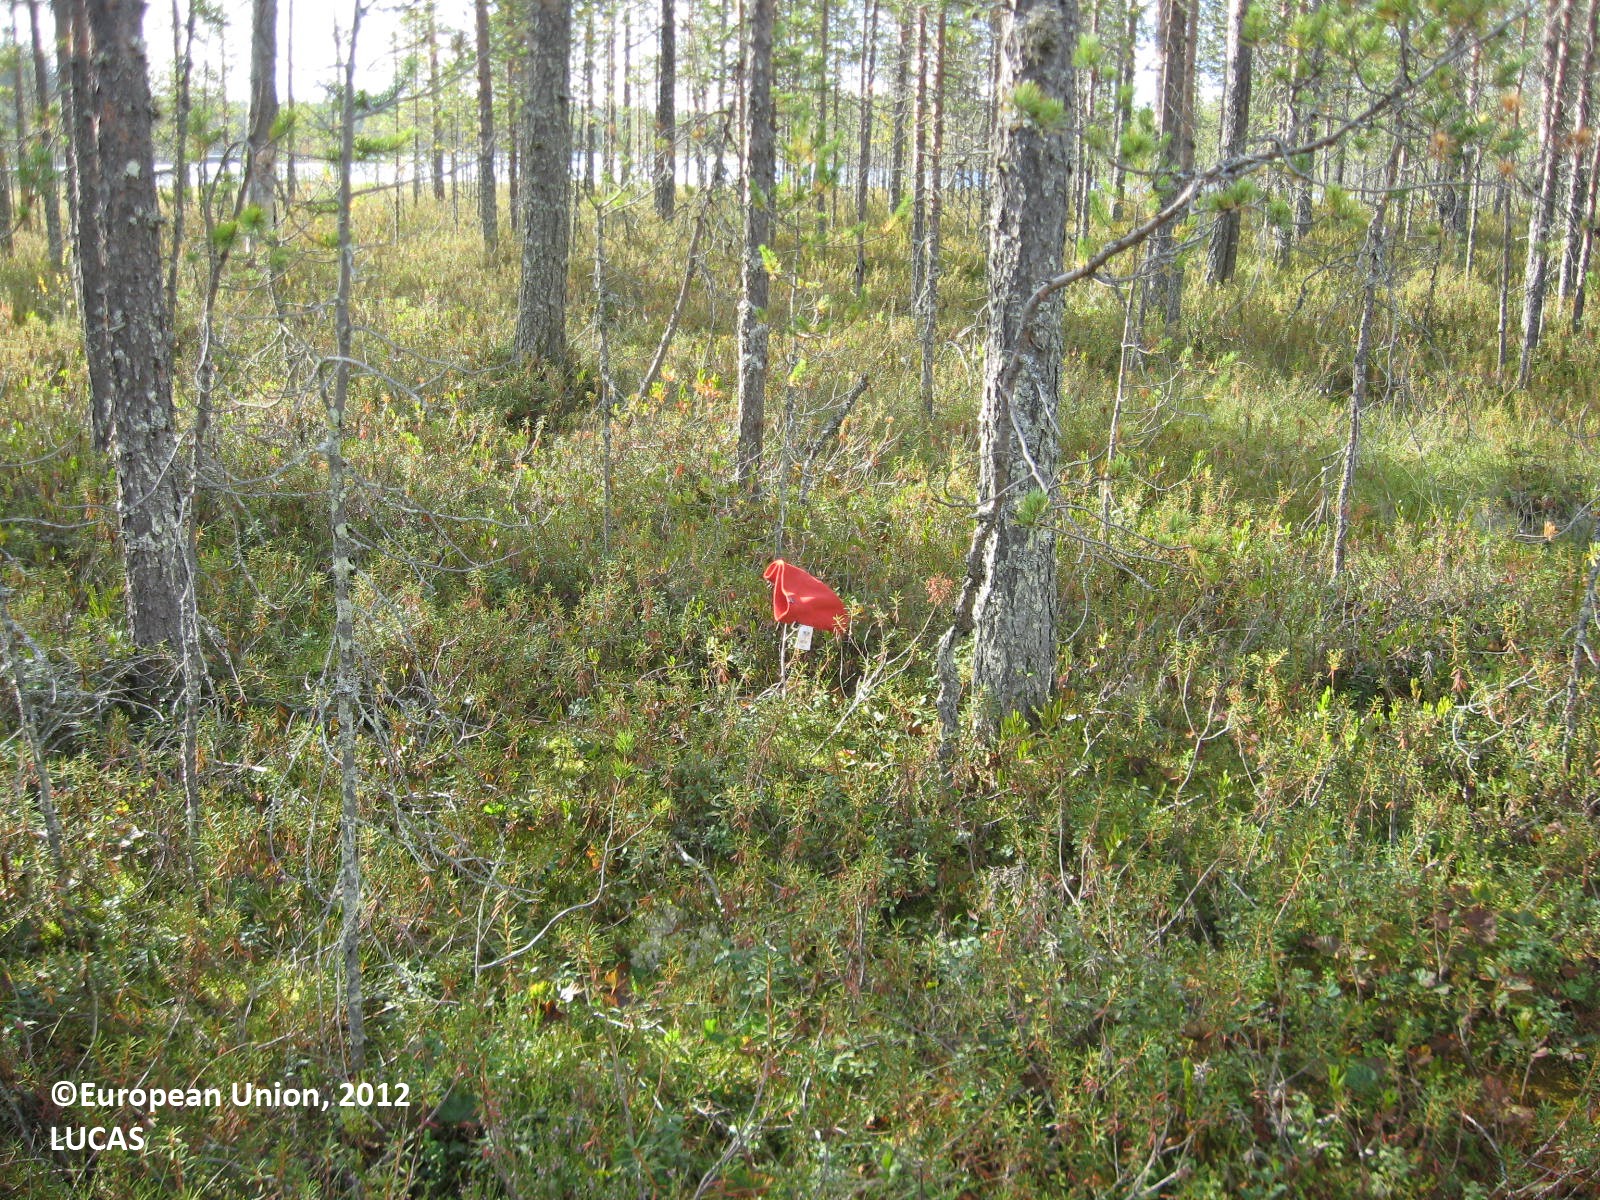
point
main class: Woodland
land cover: Pine dominated coniferous woodland
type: boreal forest
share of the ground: 50 - 75 %
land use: Semi-natural and natural areas not in use
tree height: > 5 m
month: August
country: FI
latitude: 63.8402
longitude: 29.2201
